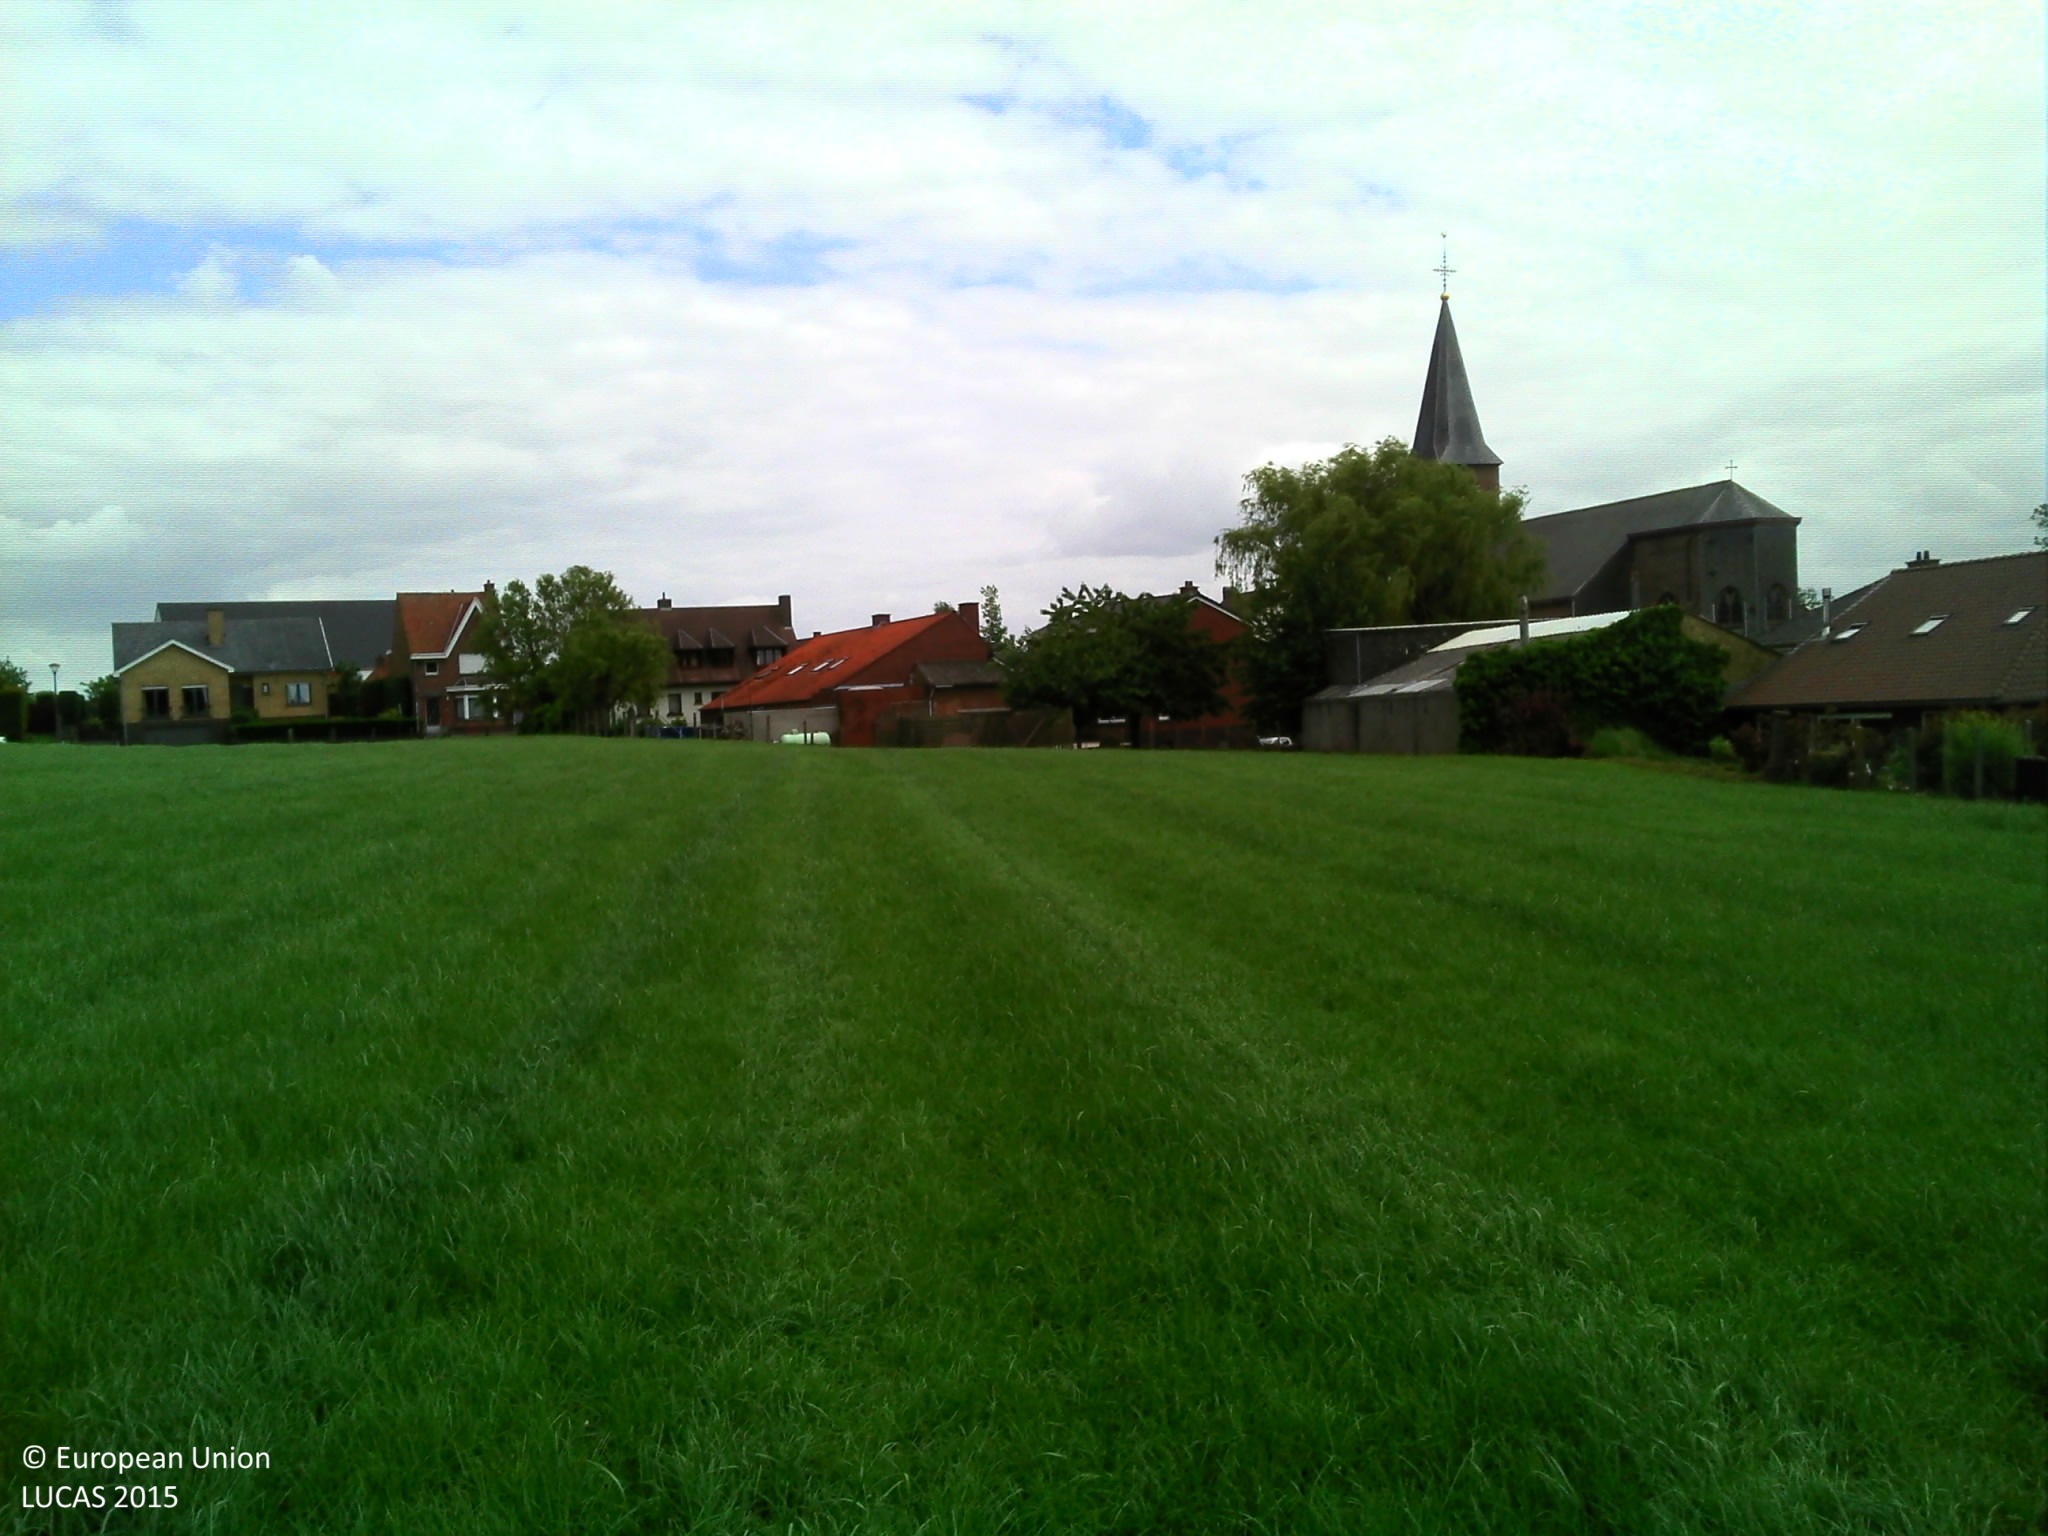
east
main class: Cropland
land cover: Temporary grasslands
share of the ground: > 75 %
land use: Agriculture (excluding fallow land and kitchen gardens)
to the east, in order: Temporary grasslands; Artificial constructions in urban areas
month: June
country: BE
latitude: 50.8288
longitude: 3.5040
